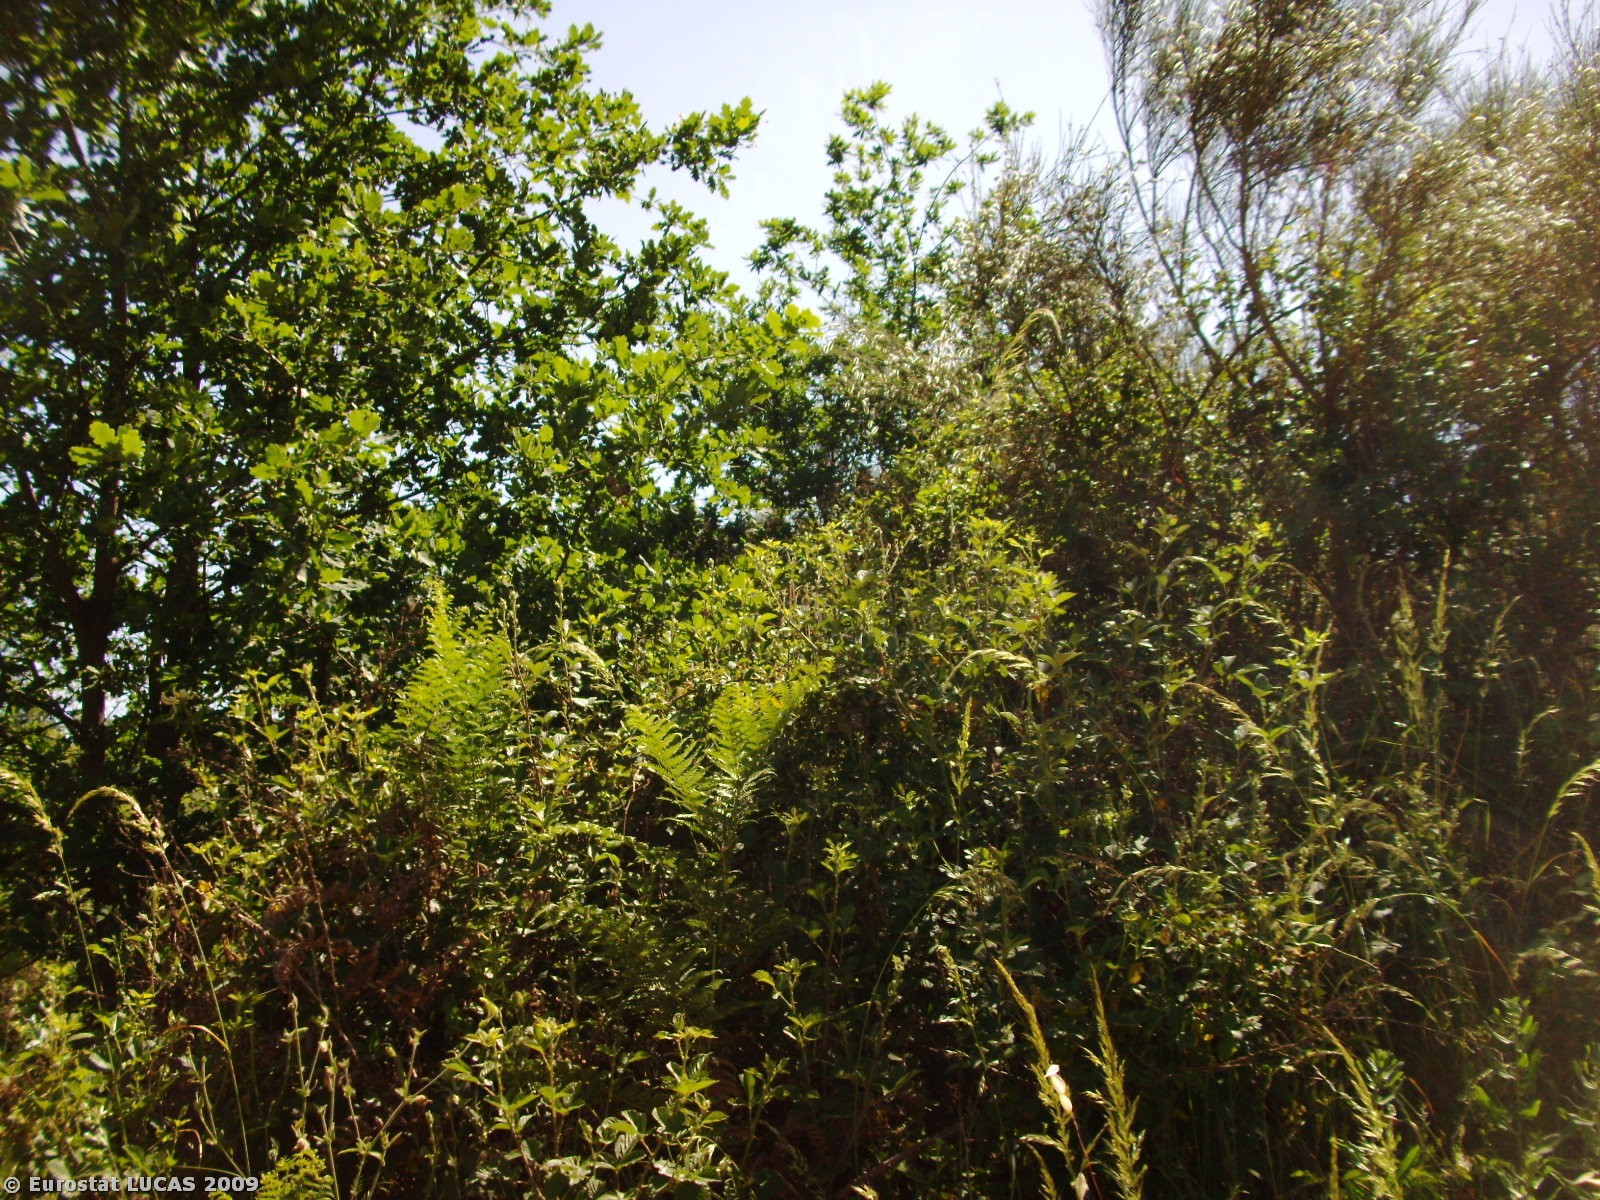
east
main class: Shrubland
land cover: Shrubland with sparse tree cover
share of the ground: > 75 %
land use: Unused
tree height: > 5 m
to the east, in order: Shrubland with sparse tree cover; Tracks; Shrubland with sparse tree cover; Shruby margins; Shrubland with sparse tree cover; Shruby margins; Shrubland with sparse tree cover; Shruby margins; Shrubland with sparse tree cover; Shruby margins; Shrubland with sparse tree cover; Shruby margins; Shrubland with sparse tree cover; Tracks; Shrubland with sparse tree cover; Mixed woodland; Paved roads, cycling and walking lanes; Shrubland with sparse tree cover
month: June
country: PT
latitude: 40.6224
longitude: -7.4780
